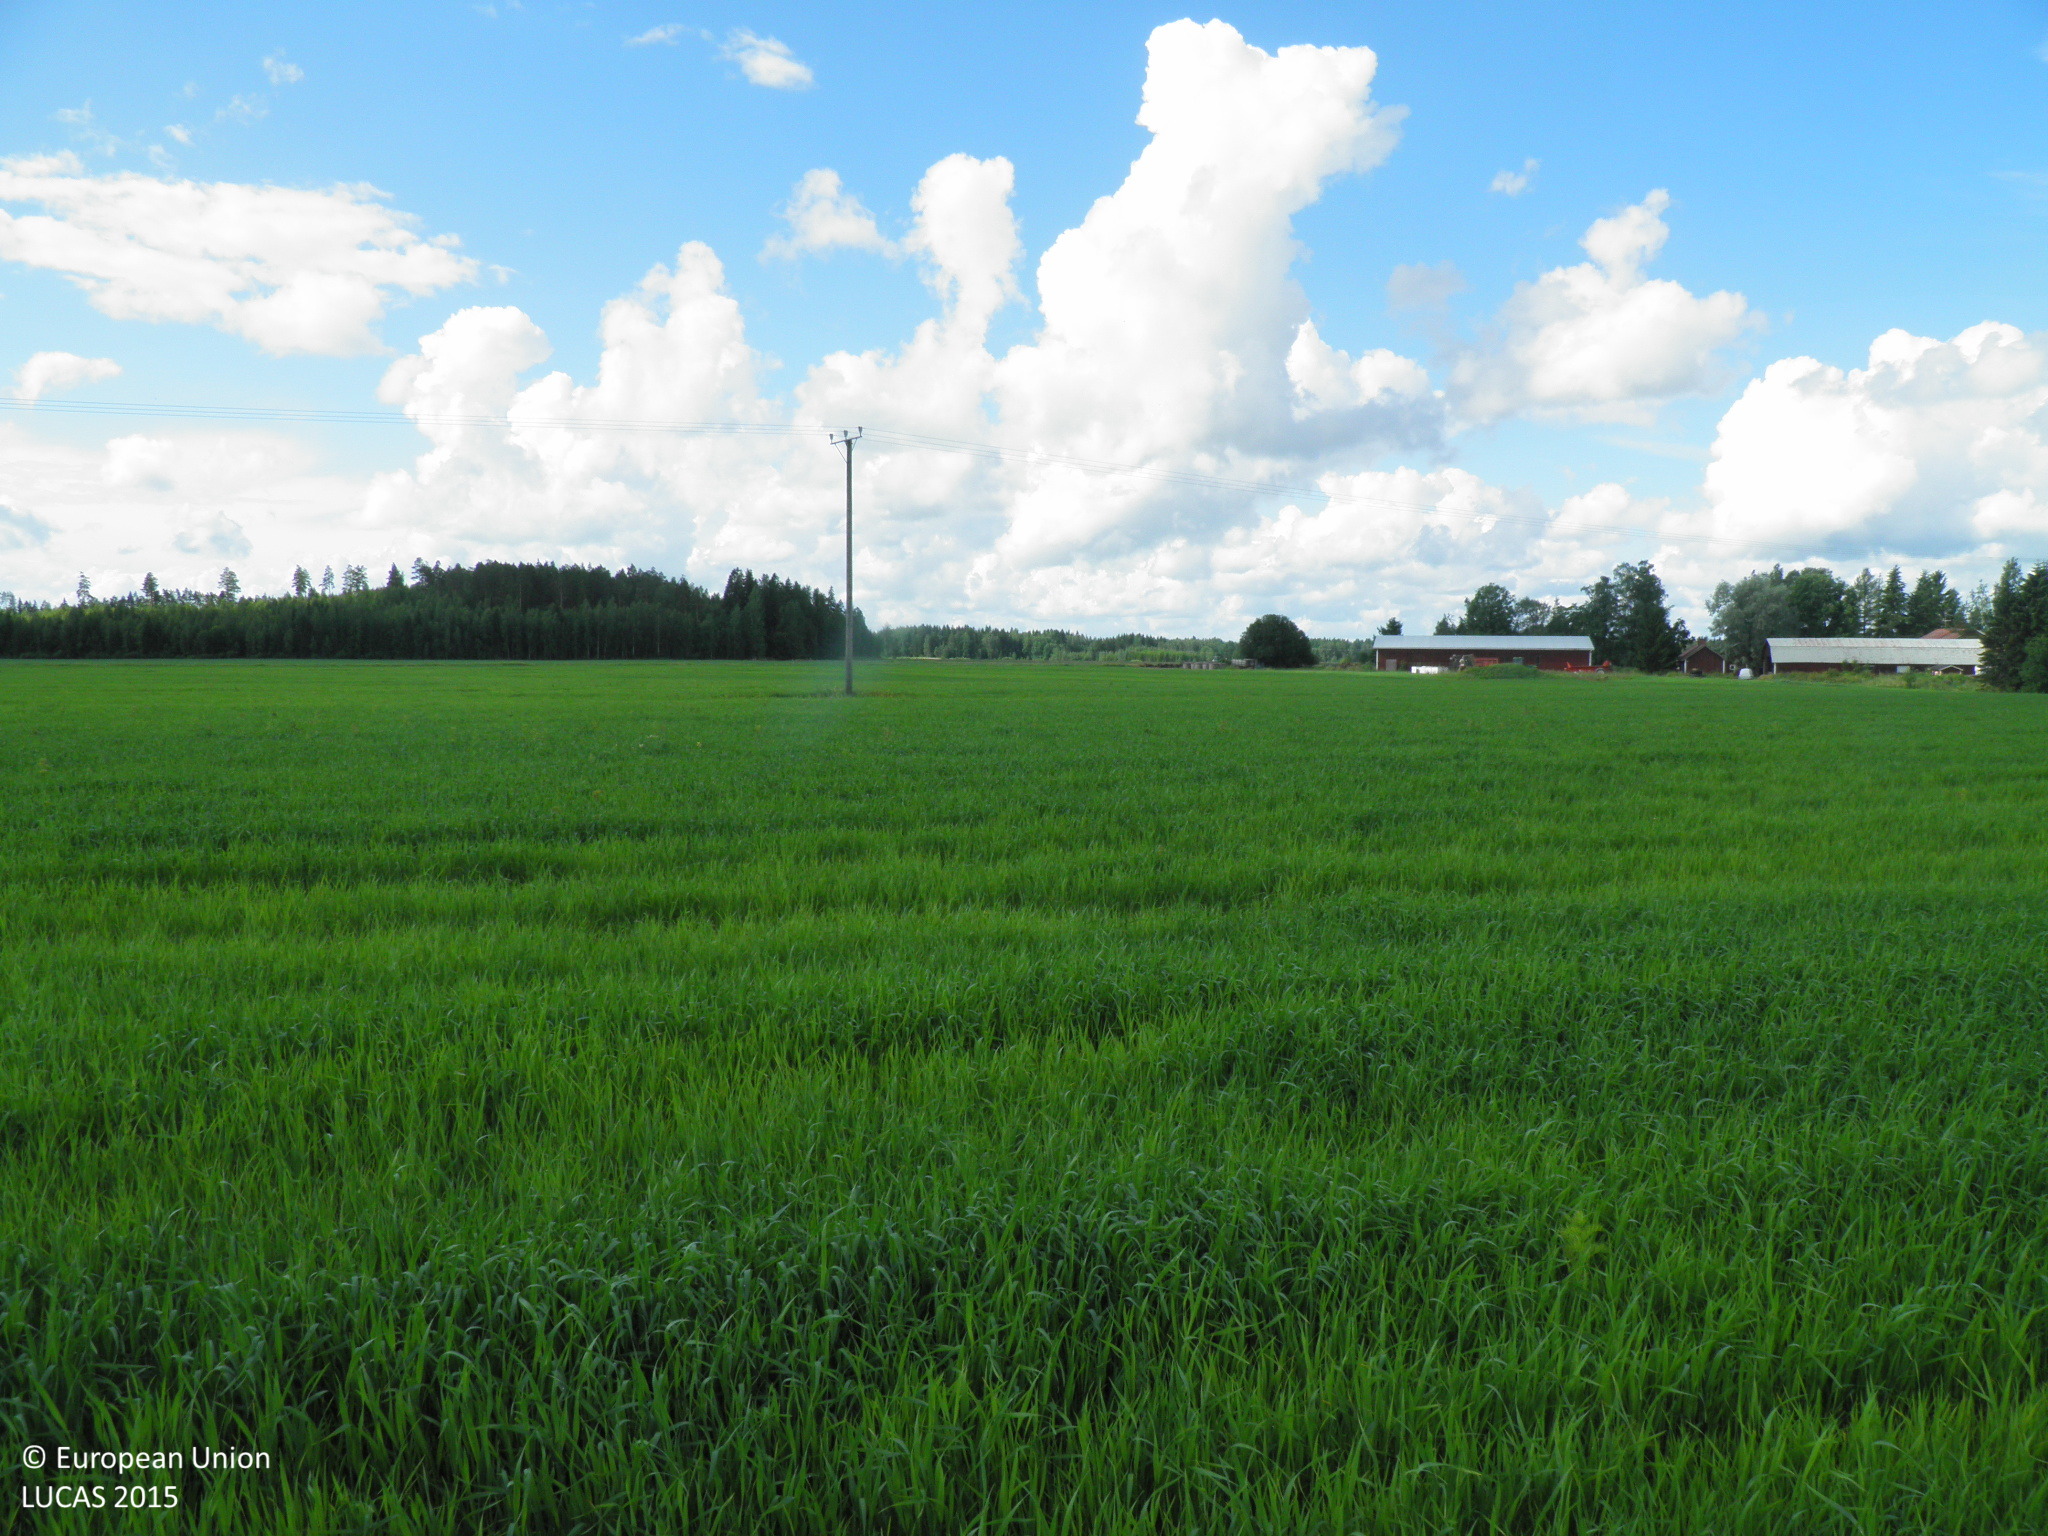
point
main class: Cropland
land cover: Common wheat
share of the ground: > 75 %
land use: Agriculture (excluding fallow land and kitchen gardens)
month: July
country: FI
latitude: 60.8289
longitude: 22.8934
